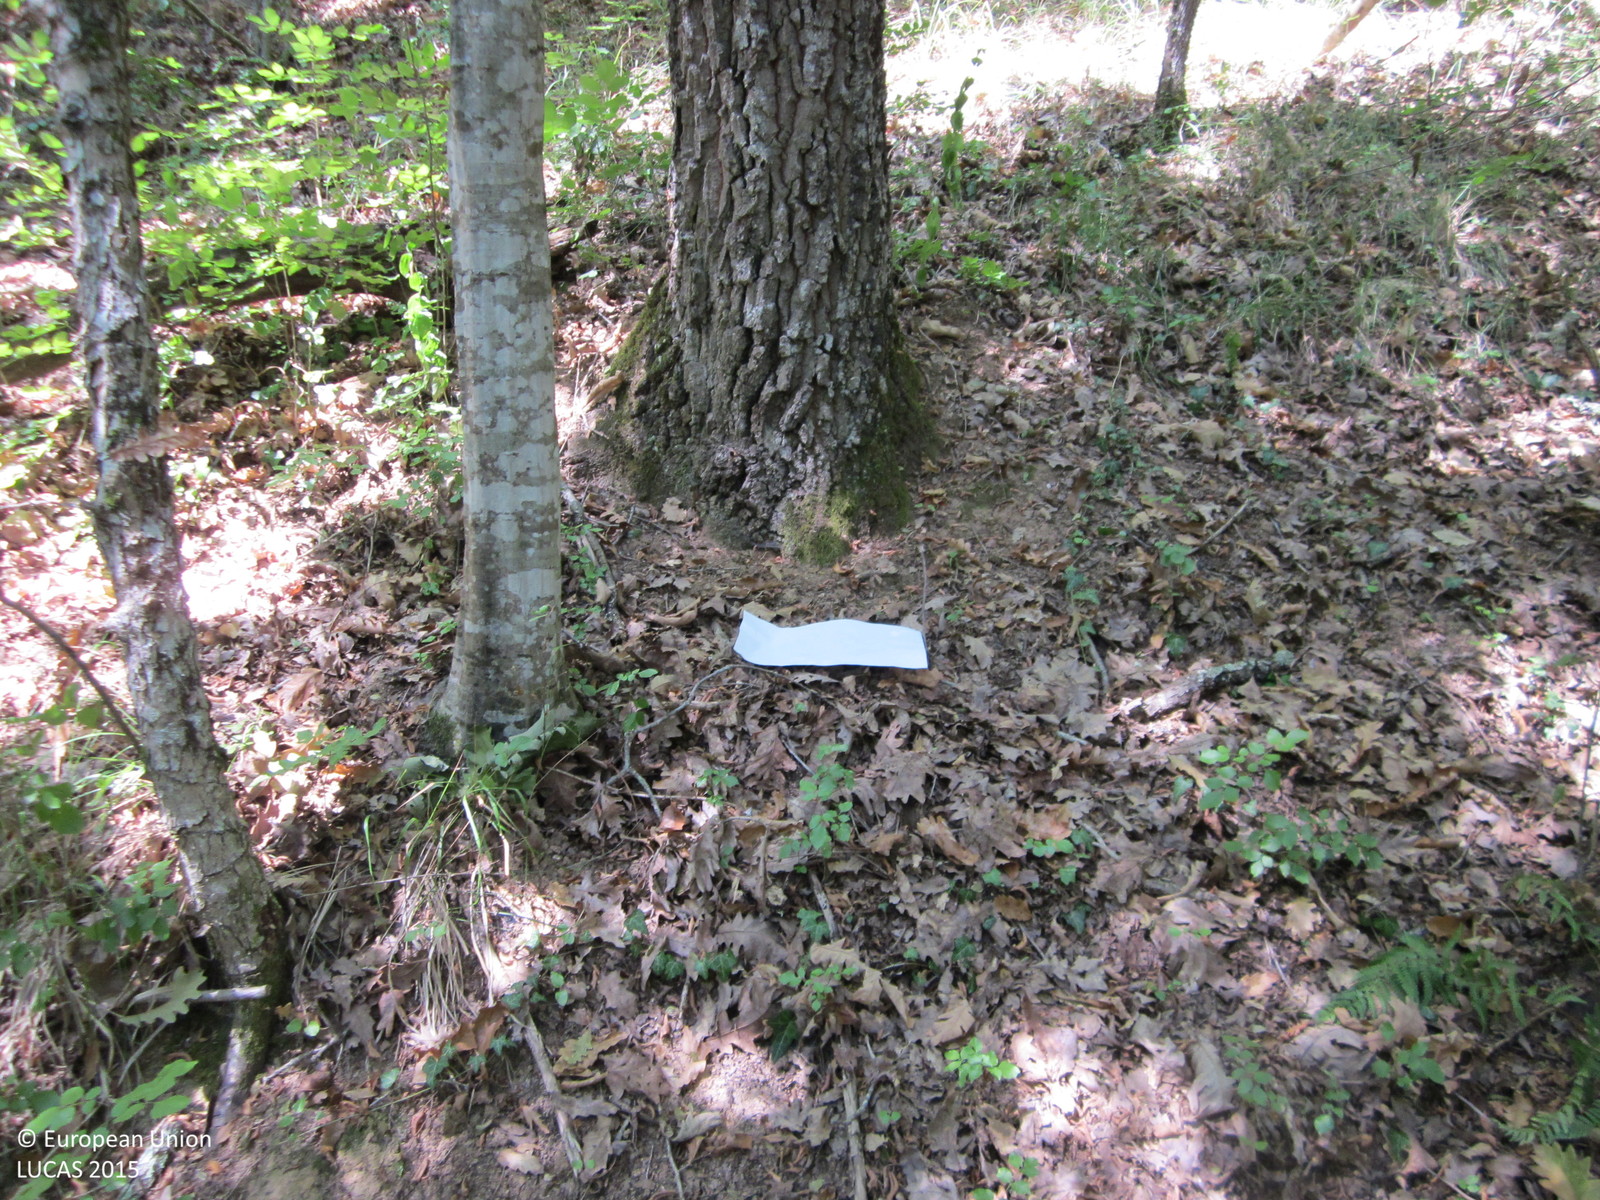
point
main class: Woodland
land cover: Broadleaved woodland
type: thermophilous deciduous forest
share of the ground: > 75 %
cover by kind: broadleaved forest trees 90 %, herbaceous plants 5 %, unconsolidated bare surface 5 %
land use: Forestry
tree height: > 5 m
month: August
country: BG
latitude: 42.0588
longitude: 27.7985
